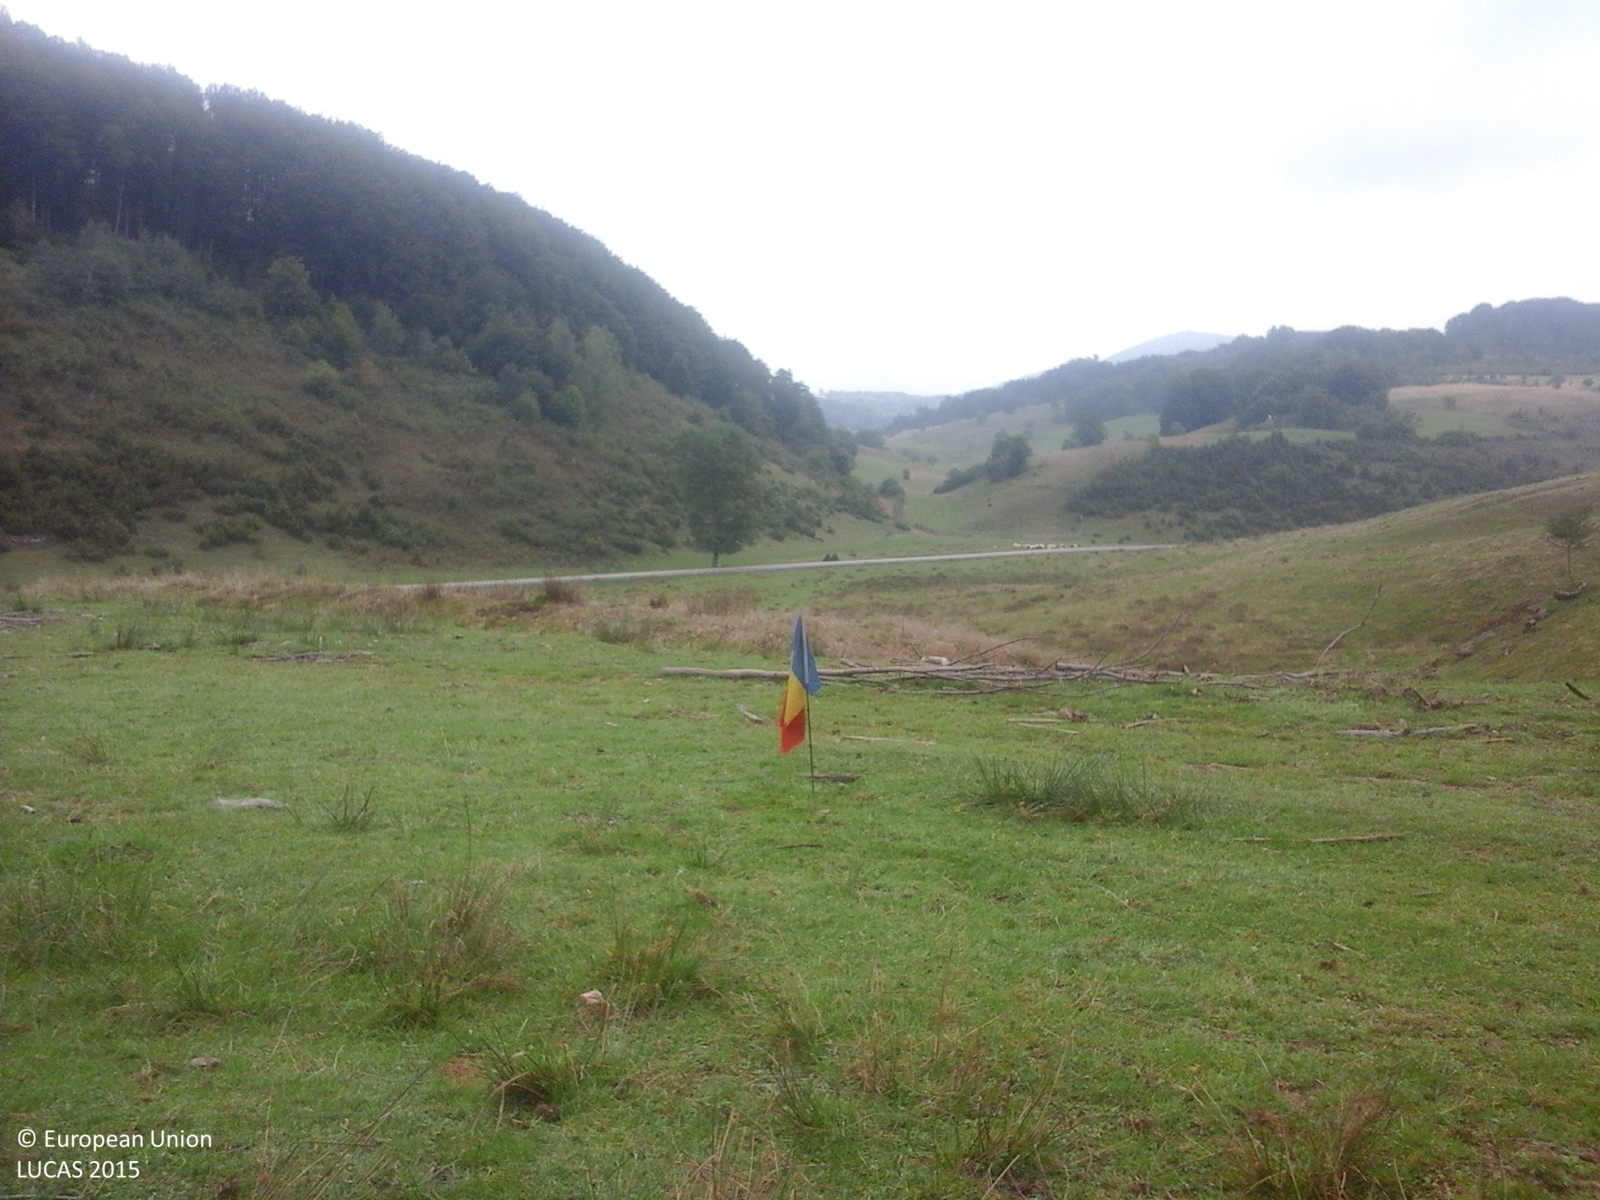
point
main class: Grassland
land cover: Grassland without tree/shrub cover
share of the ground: > 75 %
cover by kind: herbaceous plants 100 %
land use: Agriculture (excluding fallow land and kitchen gardens)
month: September
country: RO
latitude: 46.8563
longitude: 22.4740
